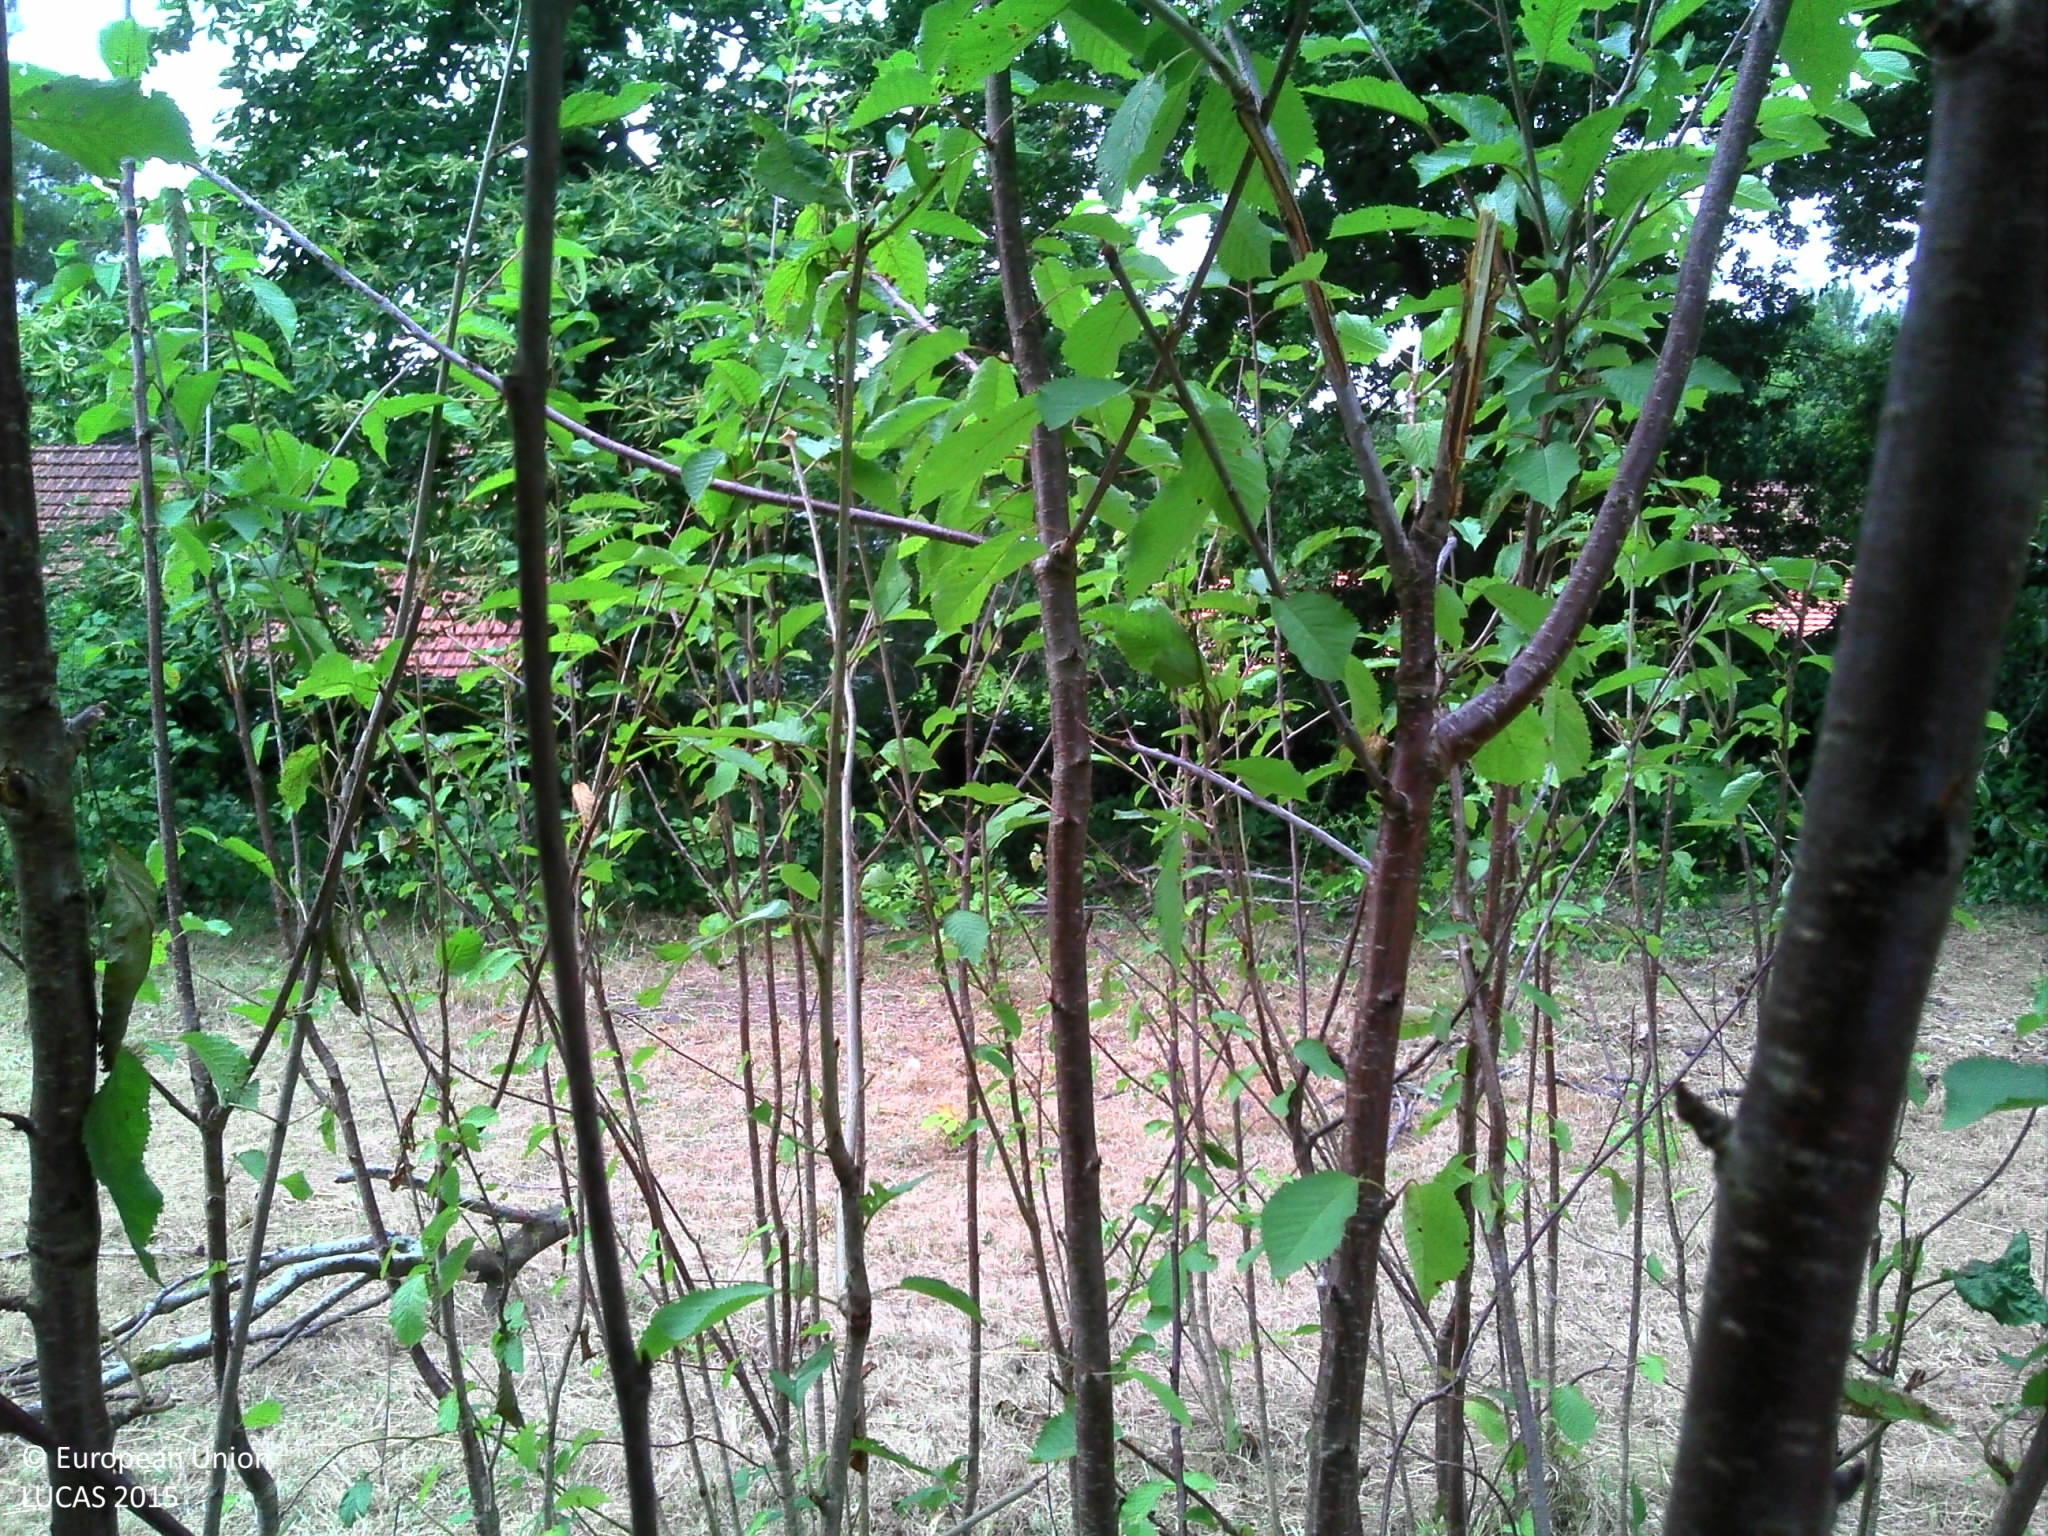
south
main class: Shrubland
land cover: Shrubland with sparse tree cover
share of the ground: > 75 %
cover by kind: shrubs 50 %, herbaceous plants 45 %, broadleaved forest trees 5 %
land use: Agriculture (excluding fallow land and kitchen gardens)
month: July
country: FR
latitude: 47.5329
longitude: -1.9645
